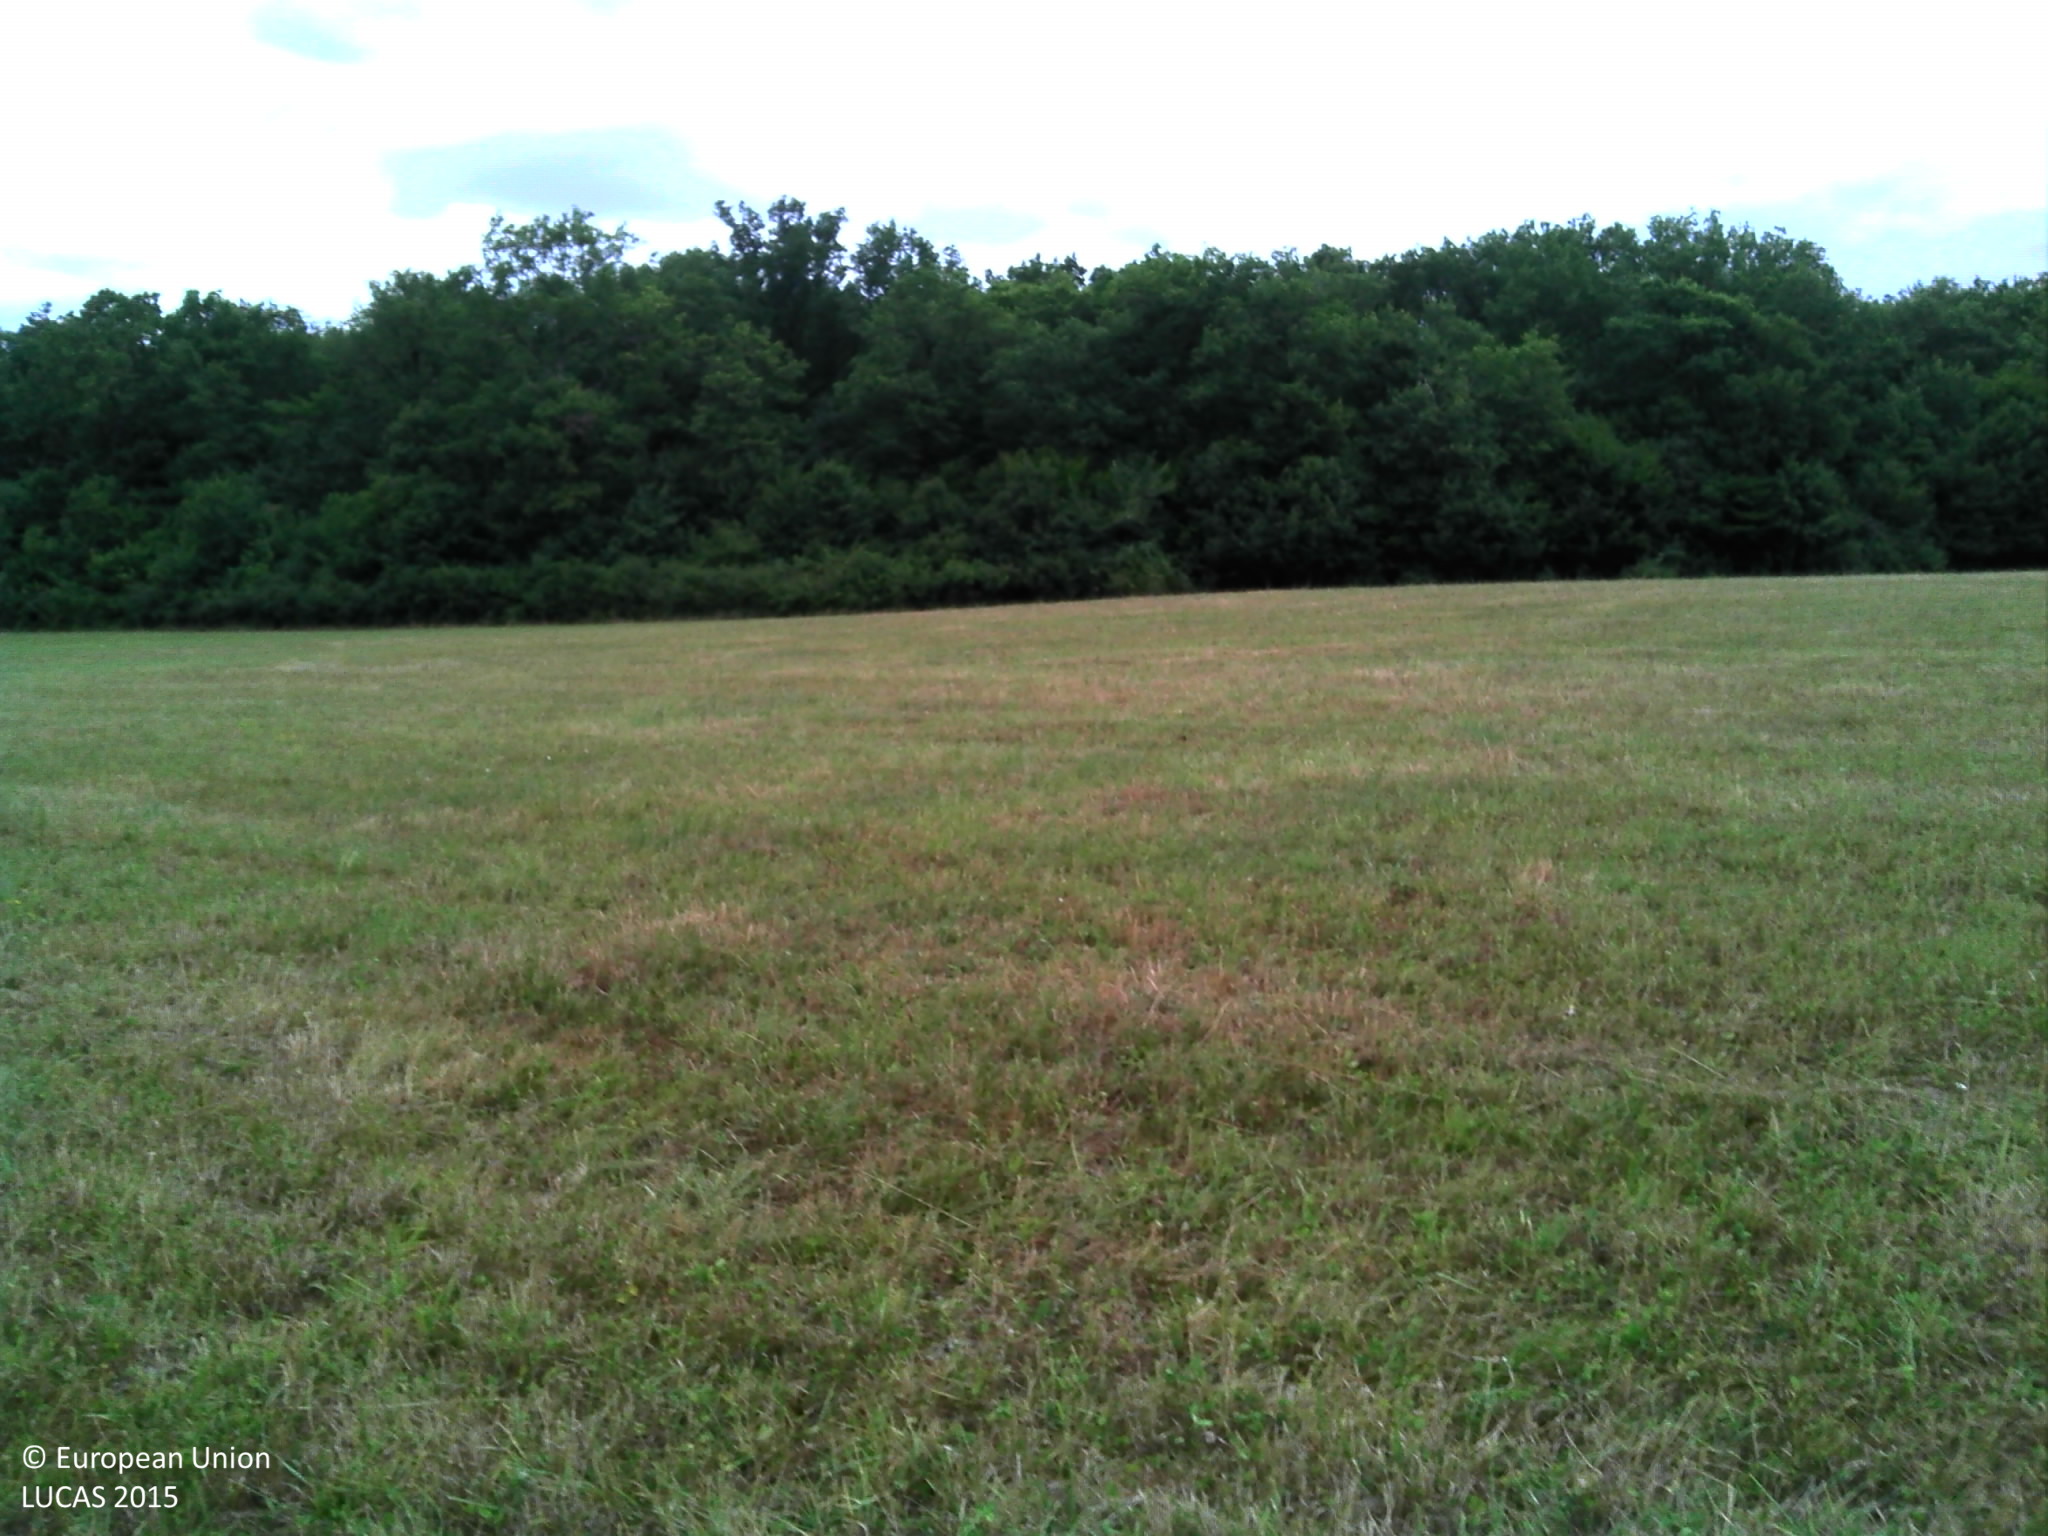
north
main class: Grassland
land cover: Grassland without tree/shrub cover
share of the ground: > 75 %
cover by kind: herbaceous plants 100 %
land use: Agriculture (excluding fallow land and kitchen gardens)
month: July
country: FR
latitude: 46.8031
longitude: 3.1964
